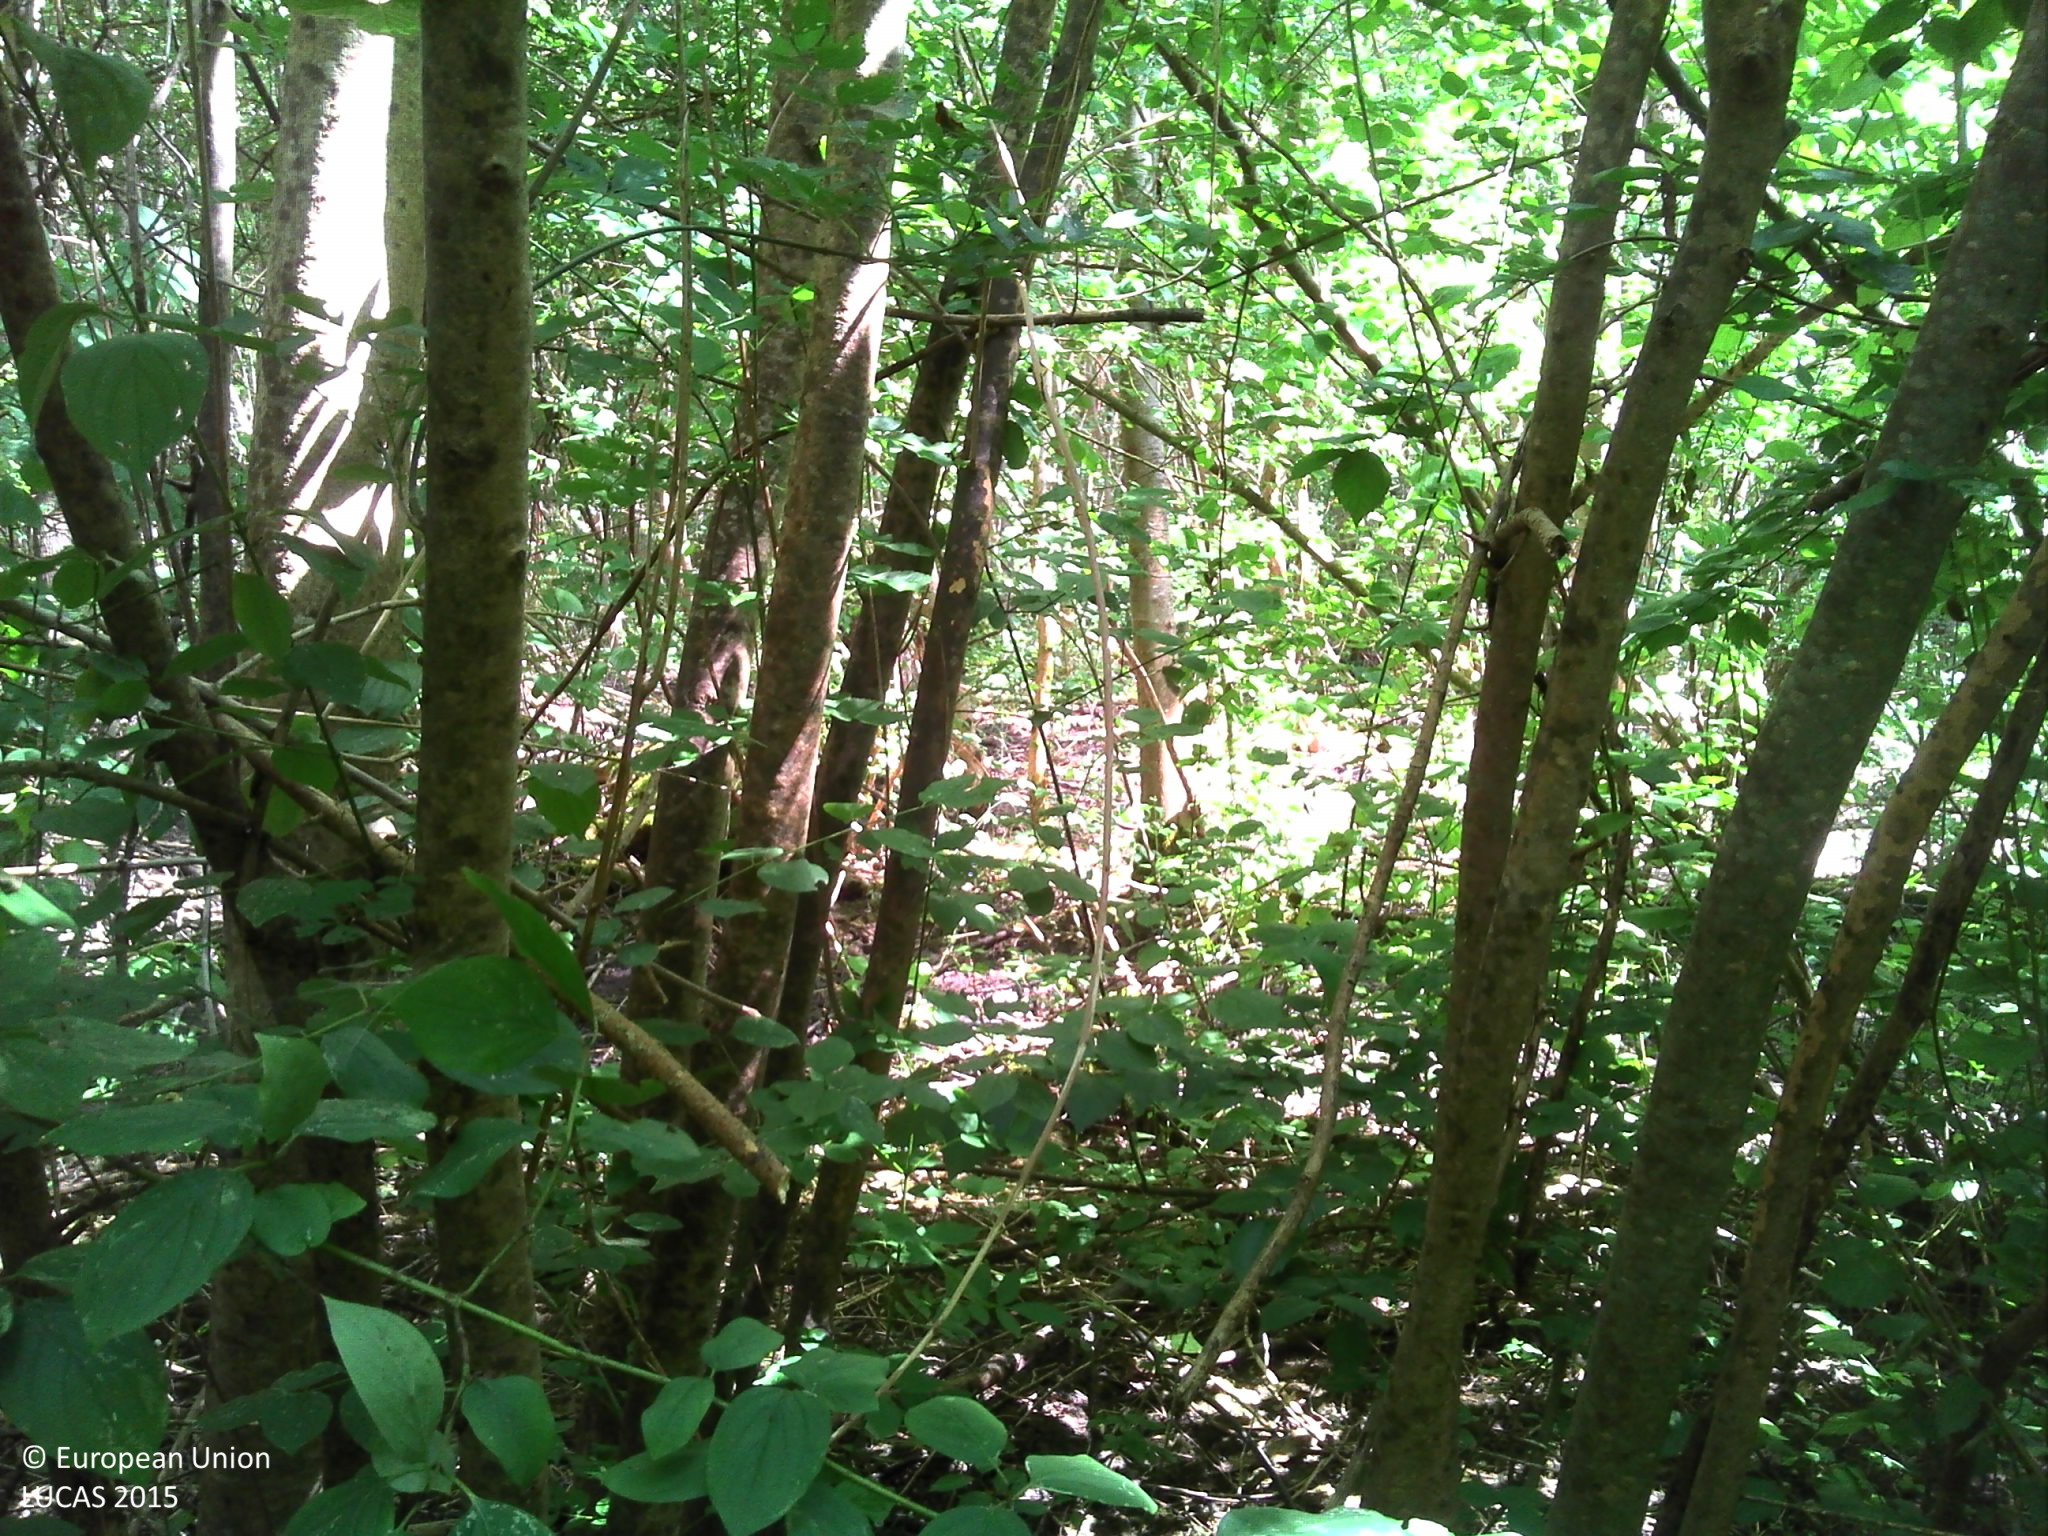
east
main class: Woodland
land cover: Broadleaved woodland
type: acidophilous oak and oak-birch forest
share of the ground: > 75 %
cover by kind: broadleaved forest trees 50 %, herbaceous plants 25 %, lichens and mosses 10 %, unconsolidated bare surface 10 %
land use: Forestry
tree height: > 5 m
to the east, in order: Broadleaved woodland; Tracks; Broadleaved woodland
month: July
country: FR
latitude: 48.5366
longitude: 3.8057
